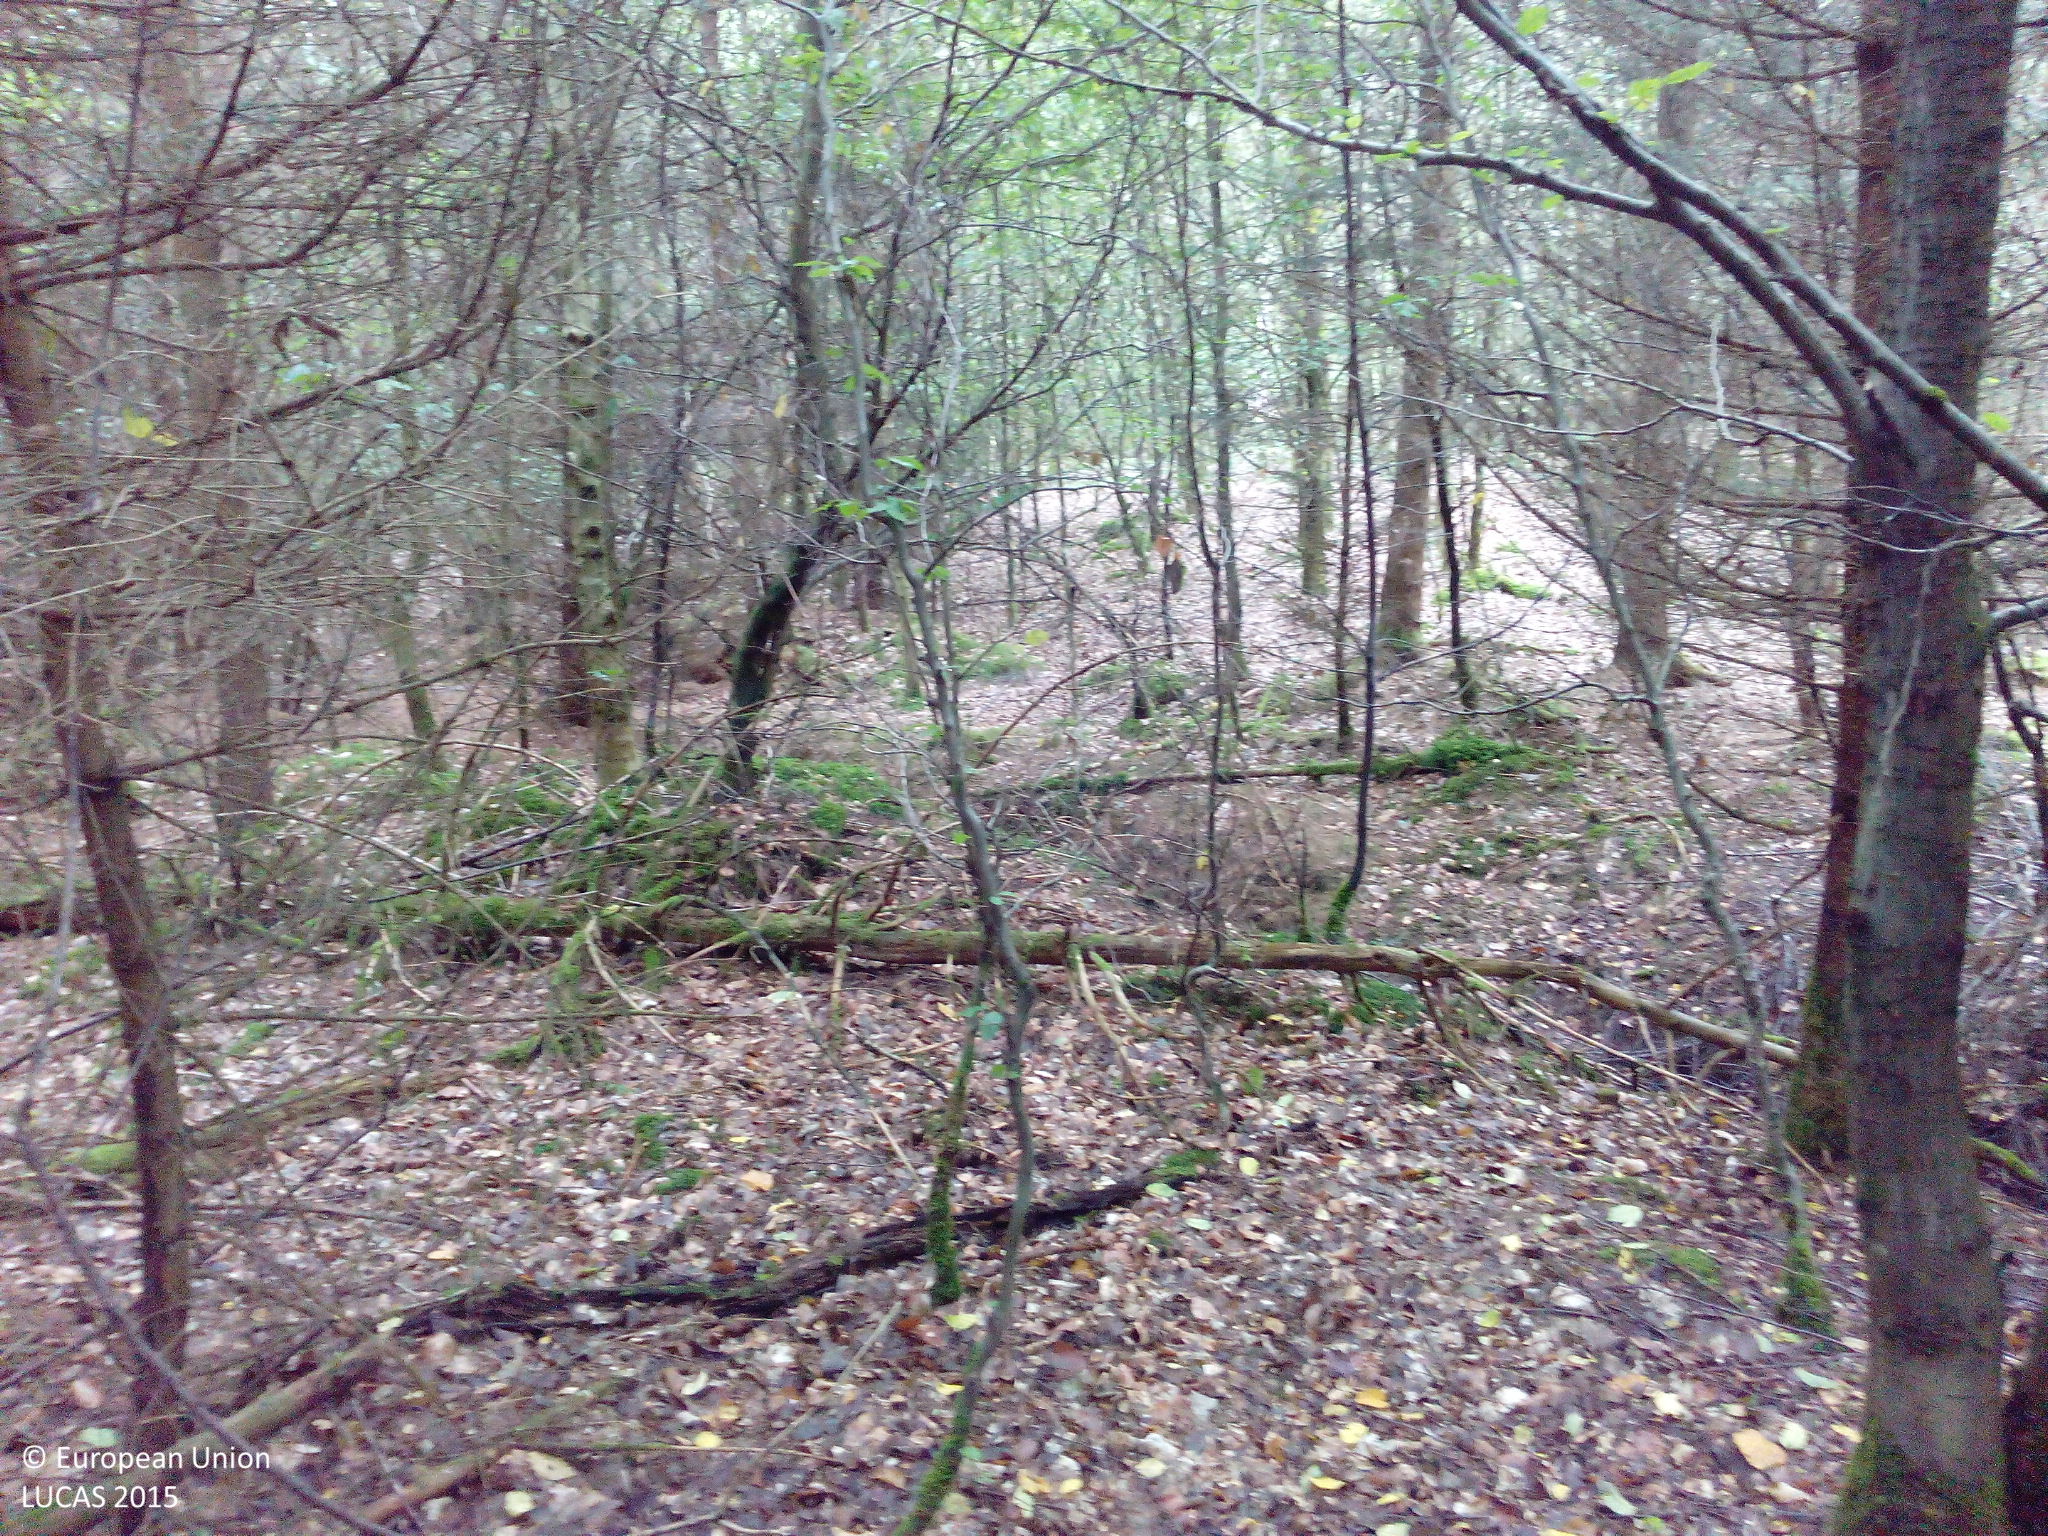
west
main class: Woodland
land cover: Spruce dominated mixed woodland
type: mesophytic deciduous forest
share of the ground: > 75 %
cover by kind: coniferous forest trees 45 %, broadleaved forest trees 45 %, unconsolidated bare surface 10 %
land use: Forestry
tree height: > 5 m
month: August
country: DE
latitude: 50.0687
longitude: 7.5833
